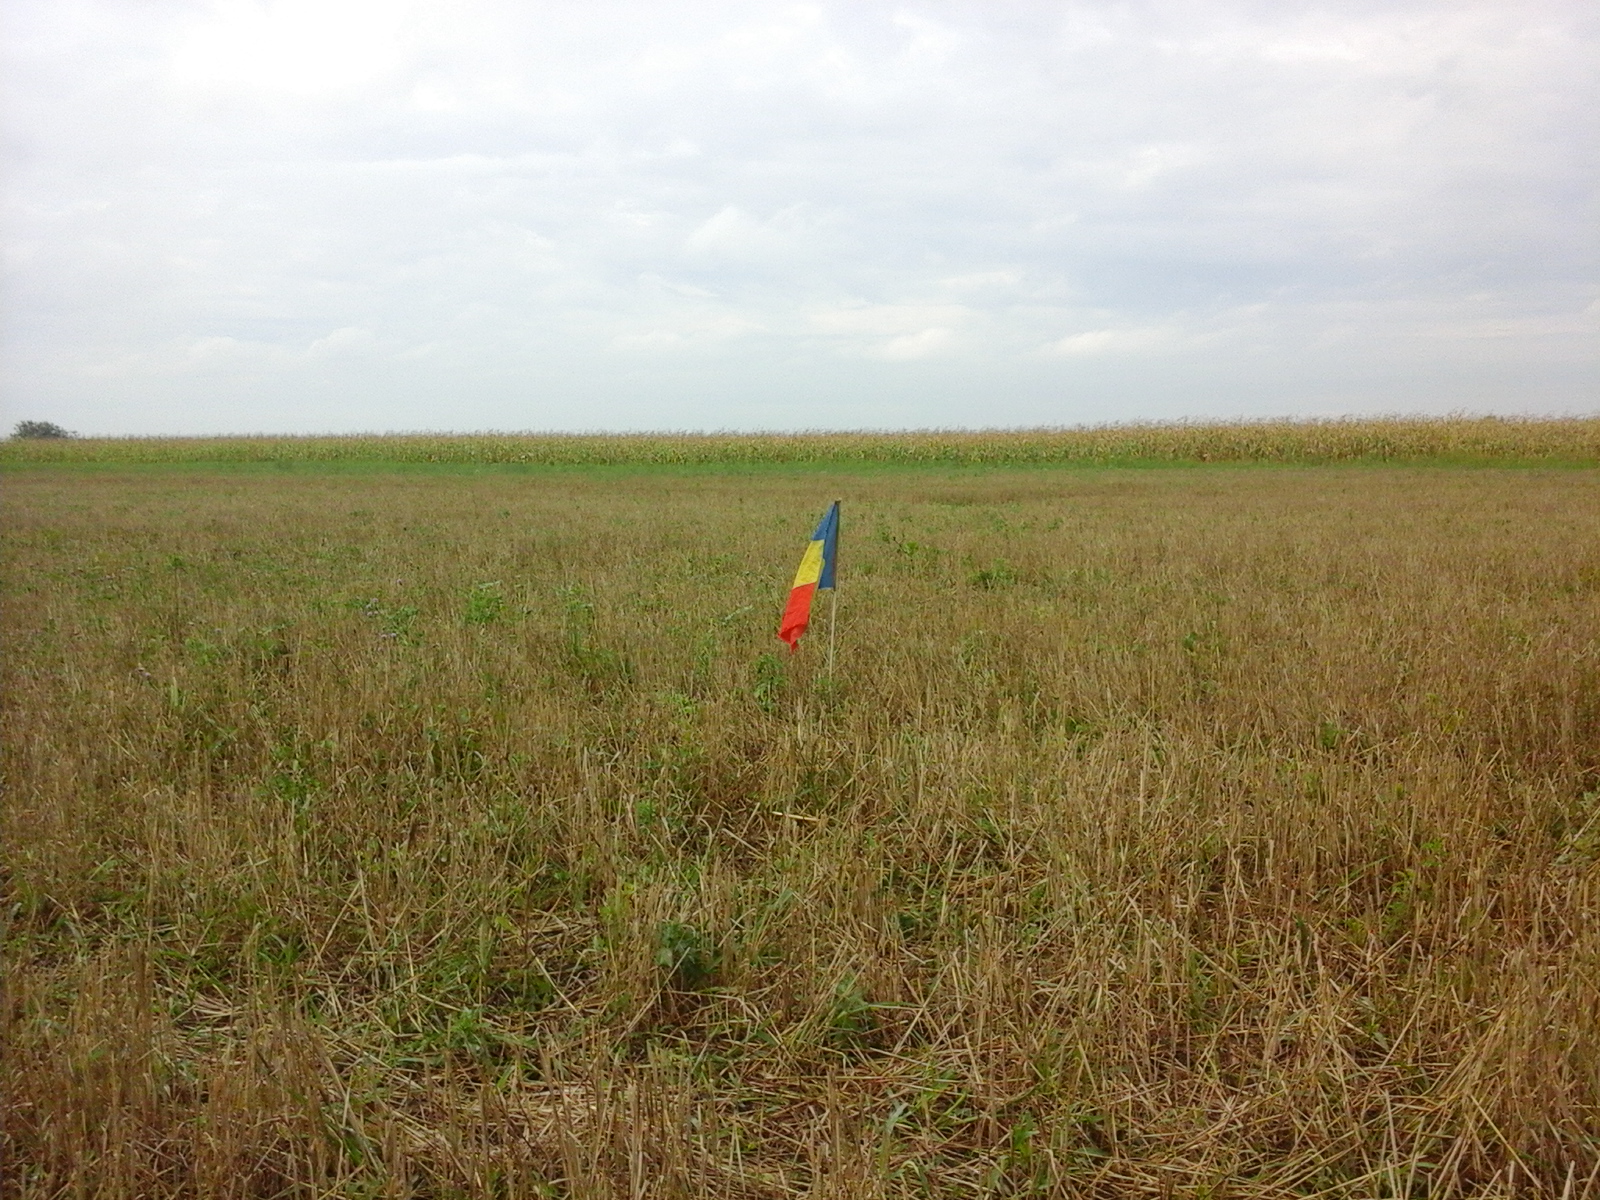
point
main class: Cropland
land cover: Common wheat
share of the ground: 50 - 75 %
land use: Agriculture (excluding fallow land and kitchen gardens)
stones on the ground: < 10 %
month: August
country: RO
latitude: 45.5816
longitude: 21.3476
